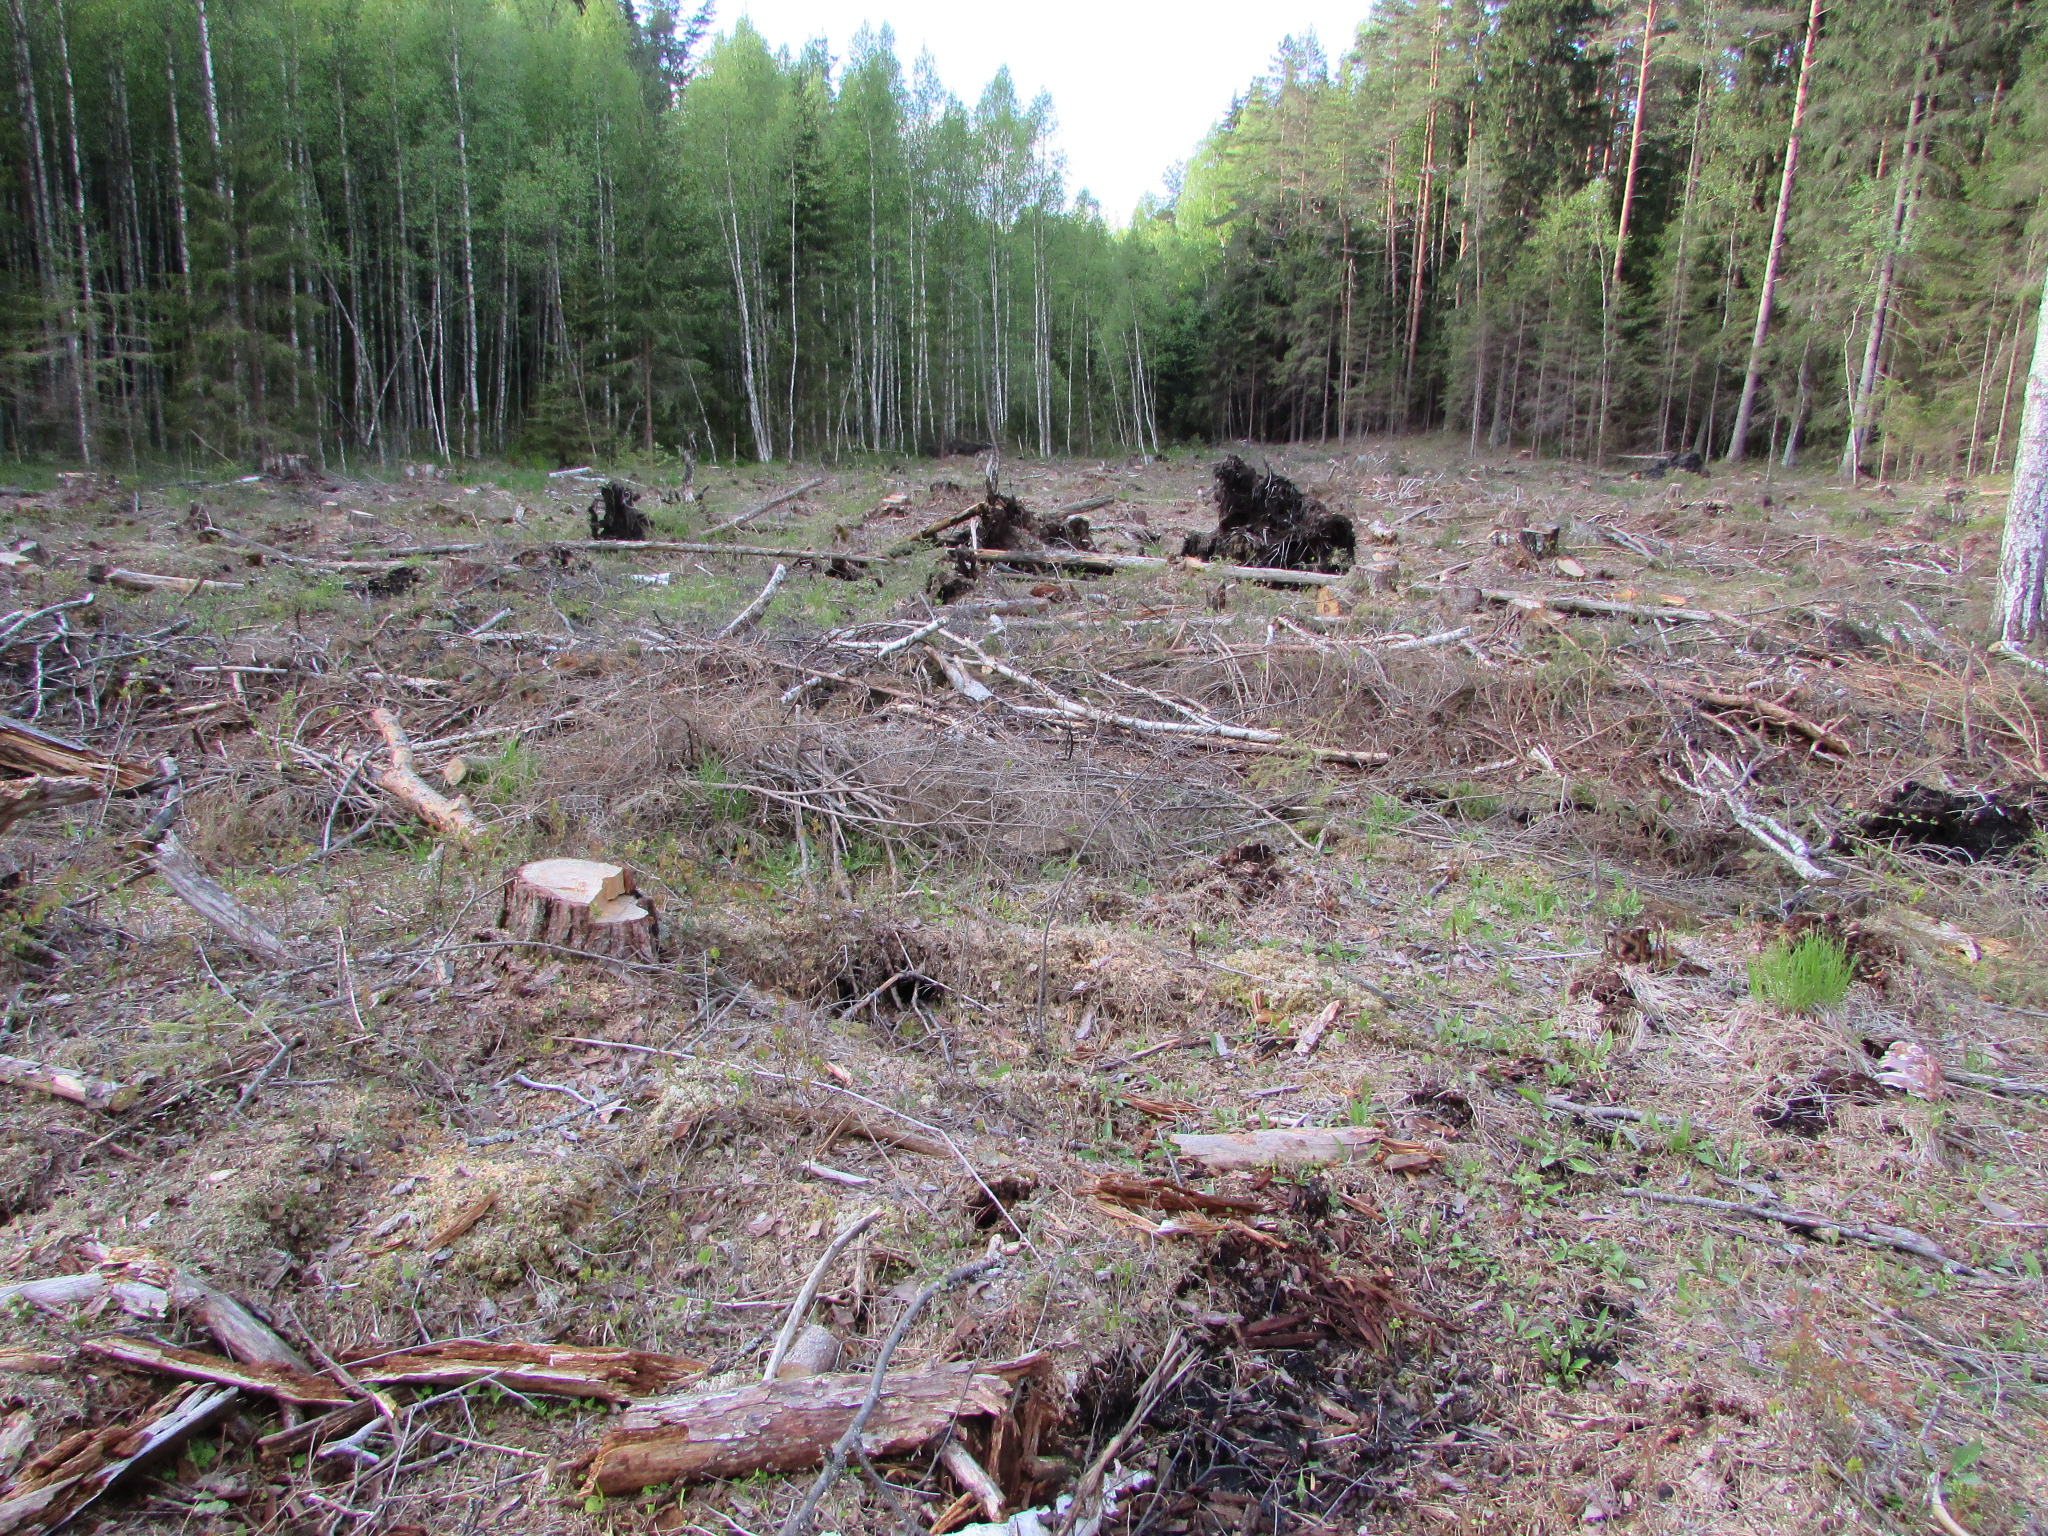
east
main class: Grassland
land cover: Spontaneously vegetated surfaces
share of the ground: 25 - 50 %
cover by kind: unconsolidated bare surface 60 %, herbaceous plants 30 %
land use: Forestry
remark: Clear cut
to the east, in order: Spontaneously vegetated surfaces; Other mixed woodland; Spruce dominated coniferous woodland; Pine dominated coniferous woodland; Tracks; Pine dominated coniferous woodland
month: May
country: LV
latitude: 56.1618
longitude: 27.1575
